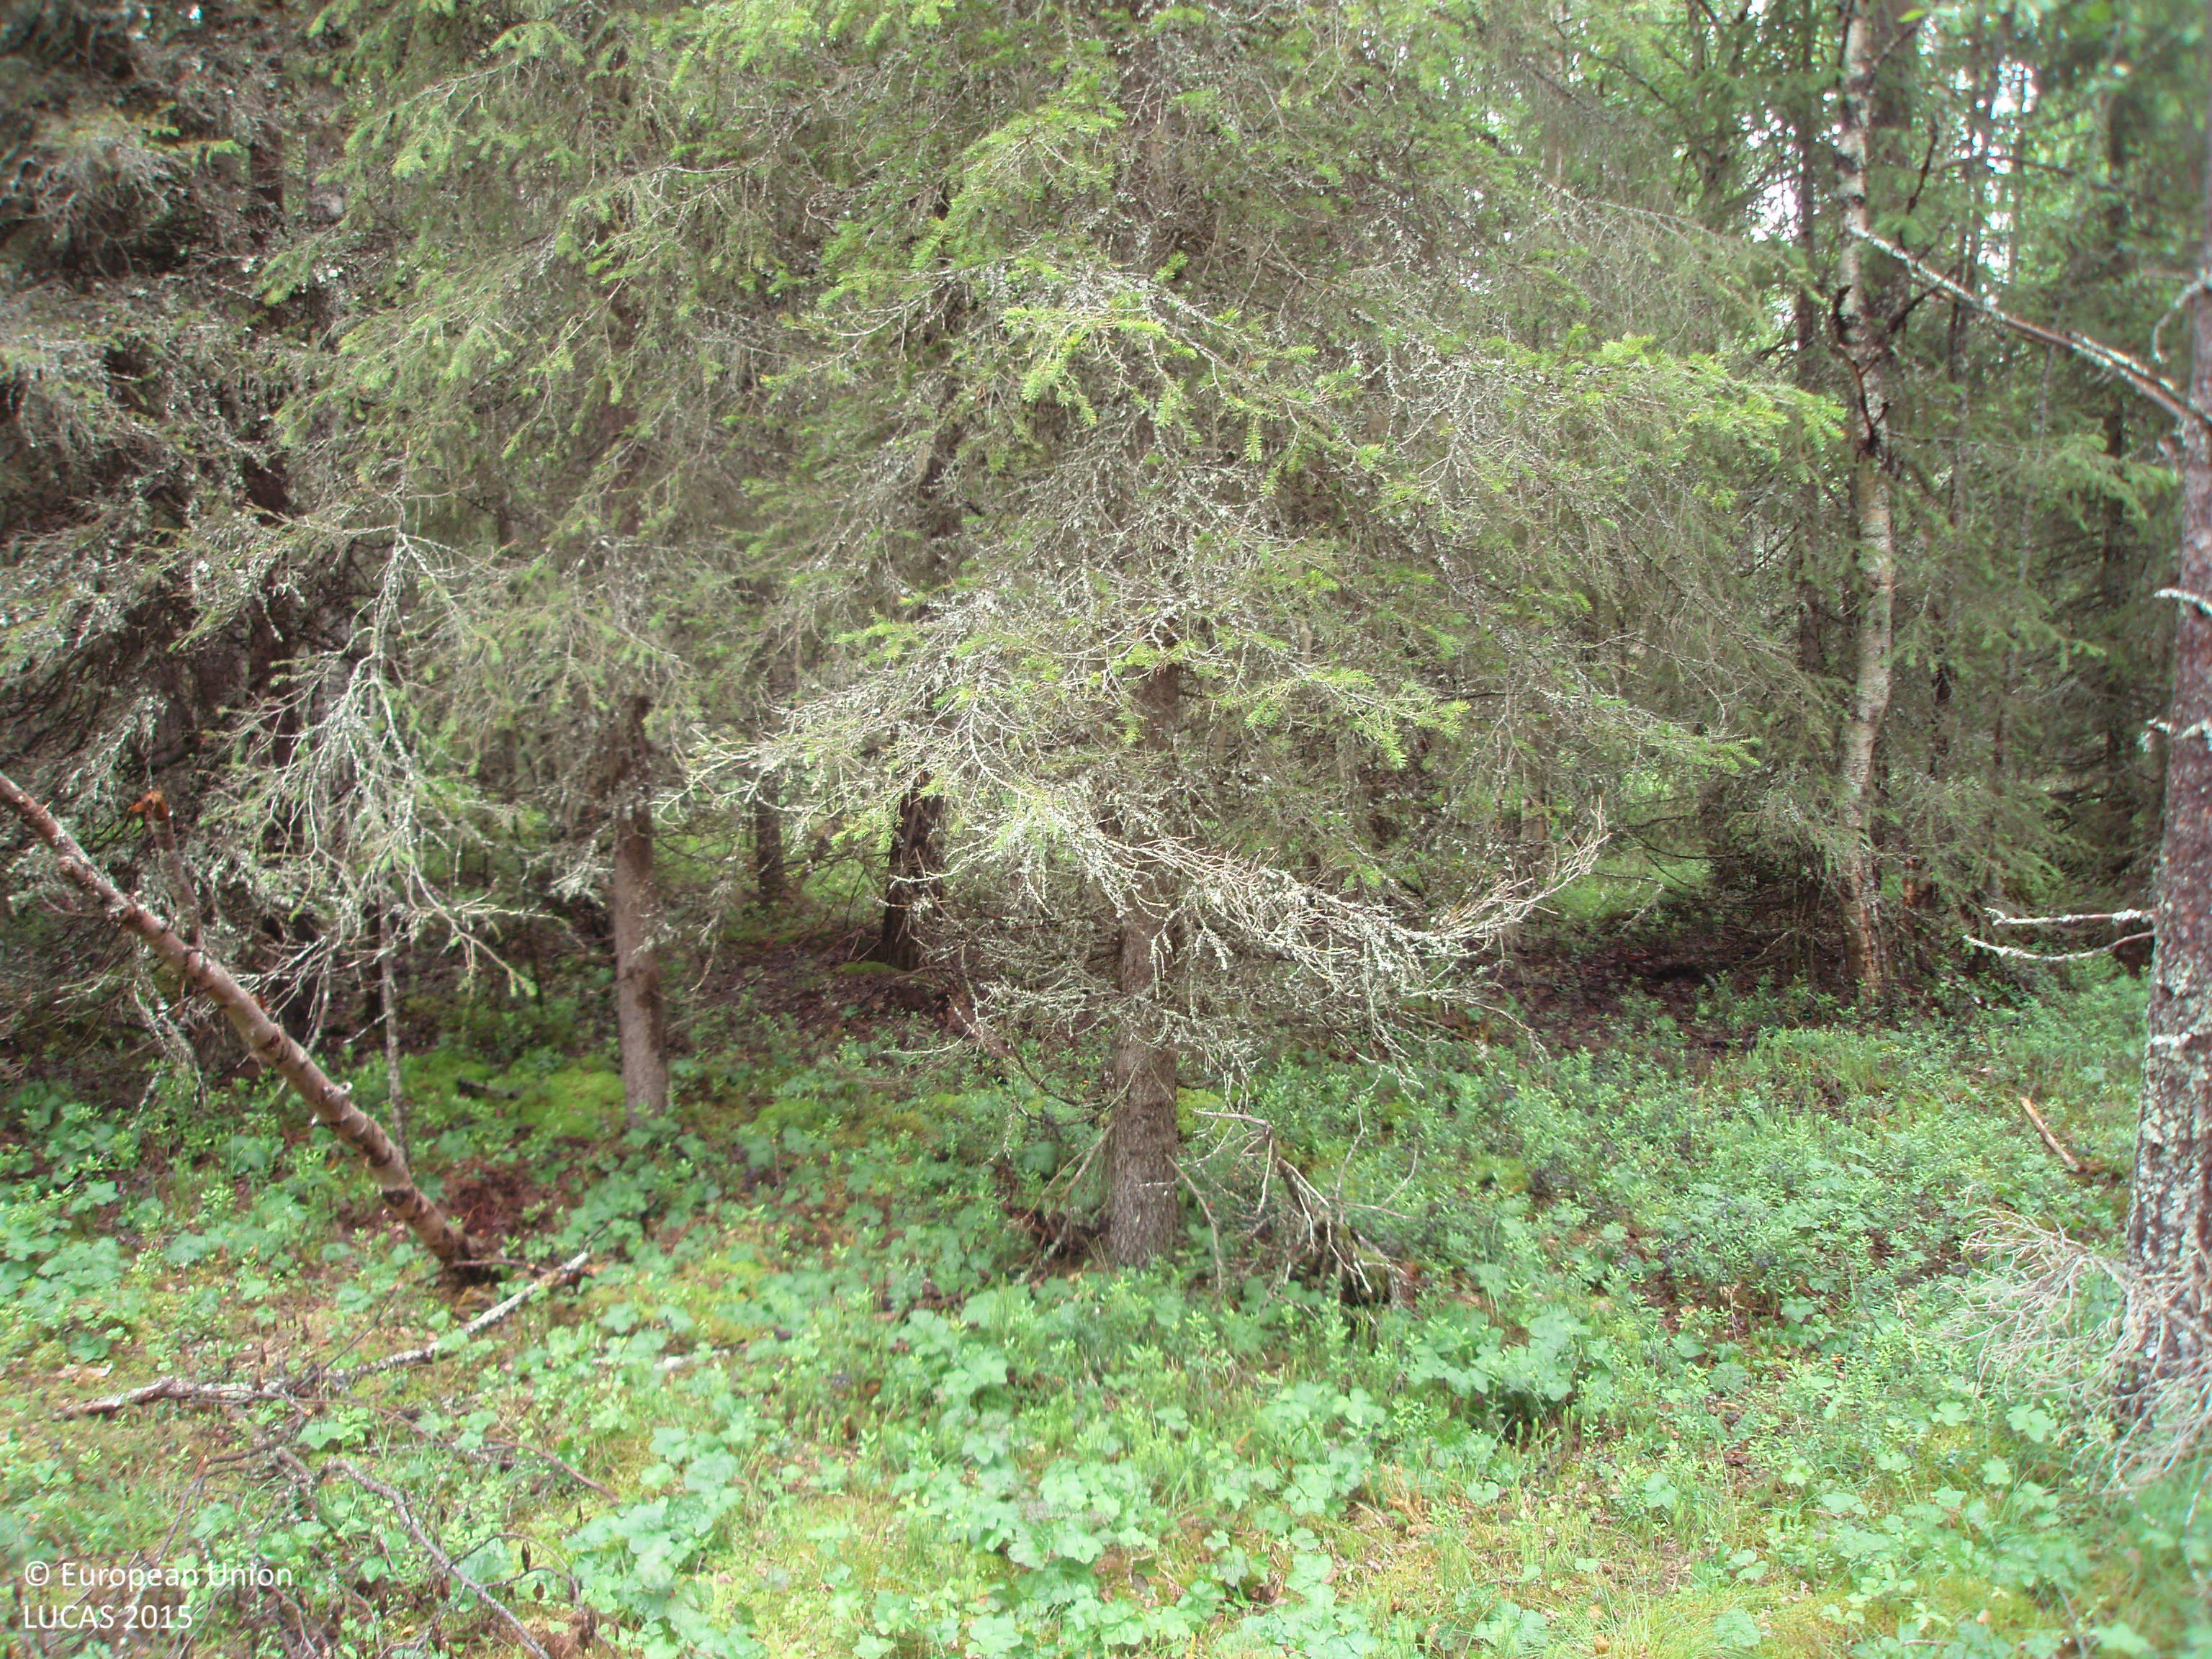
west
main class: Woodland
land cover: Spruce dominated coniferous woodland
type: boreal forest
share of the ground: > 75 %
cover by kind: coniferous forest trees 65 %, broadleaved forest trees 20 %, shrubs 10 %, herbaceous plants 5 %
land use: Forestry
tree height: > 5 m
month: July
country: FI
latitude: 65.9738
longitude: 27.9426
